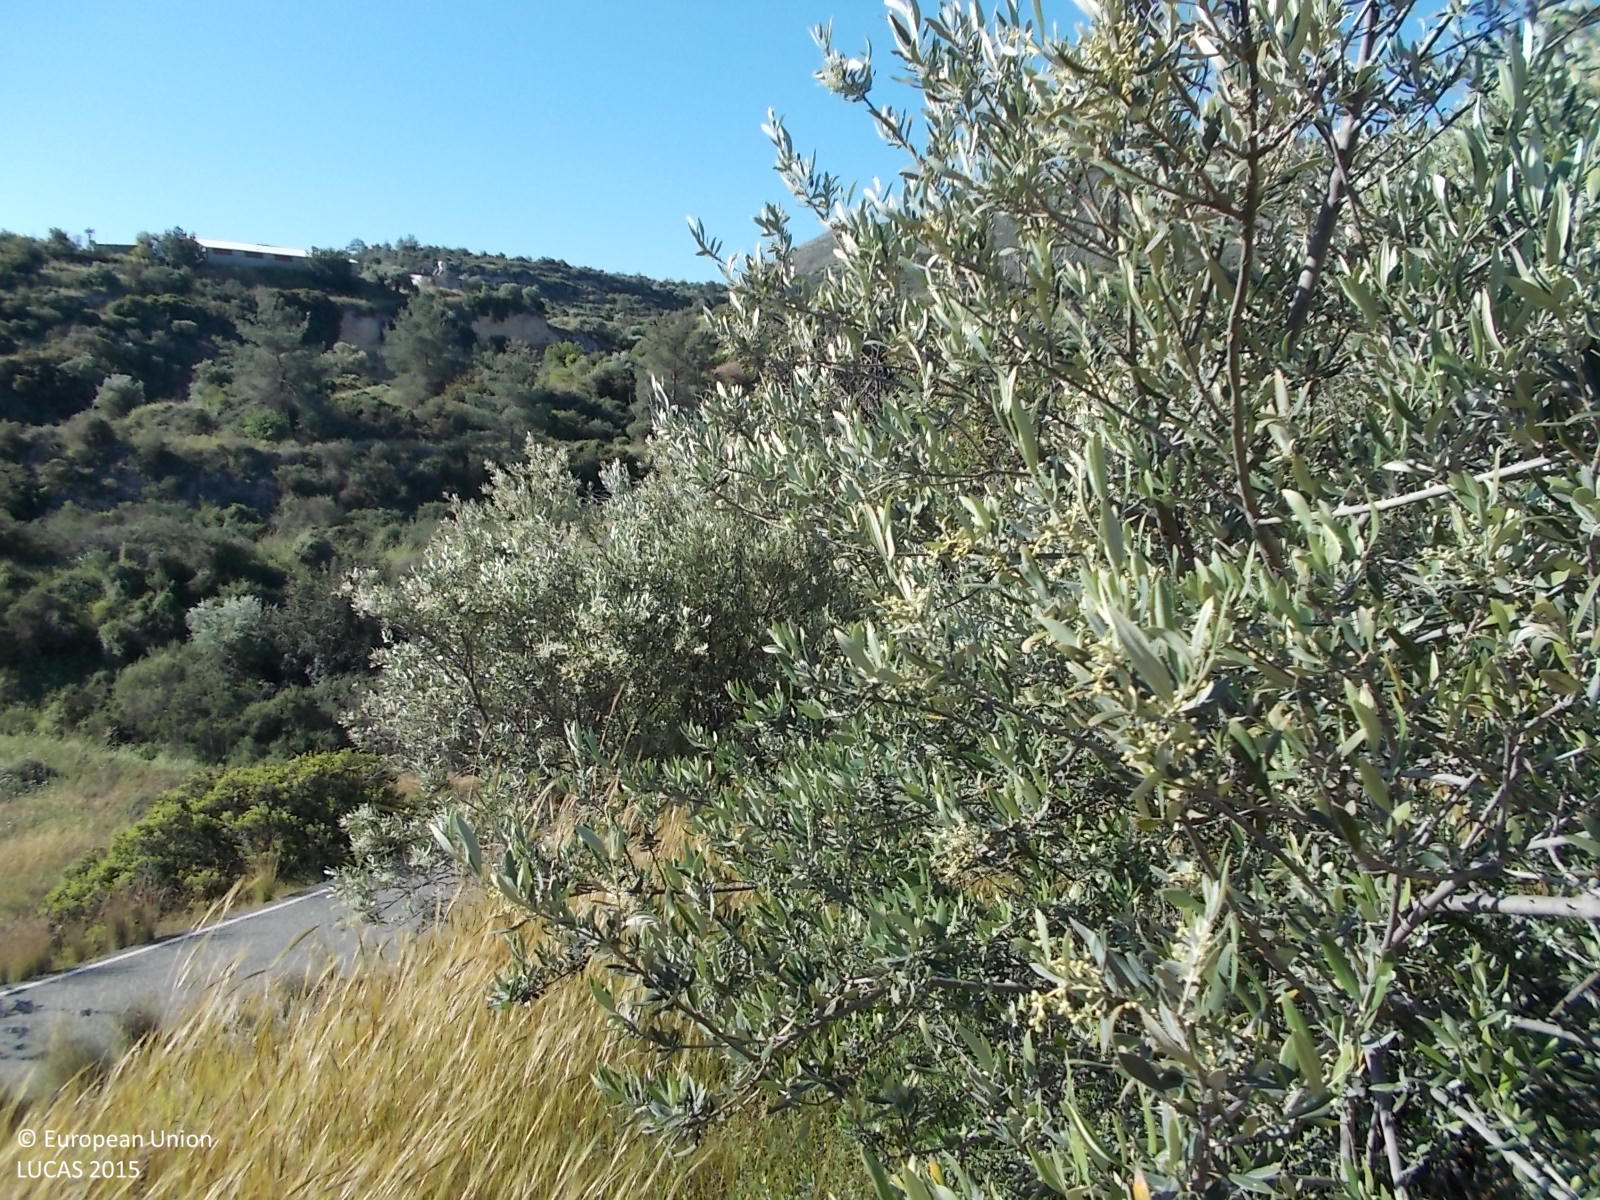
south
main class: Cropland
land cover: Olive groves
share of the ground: 25 - 50 %
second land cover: Grassland without tree/shrub cover
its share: > 75 %
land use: Abandoned areas
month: April
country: CY
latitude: 34.7782
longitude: 33.0616
